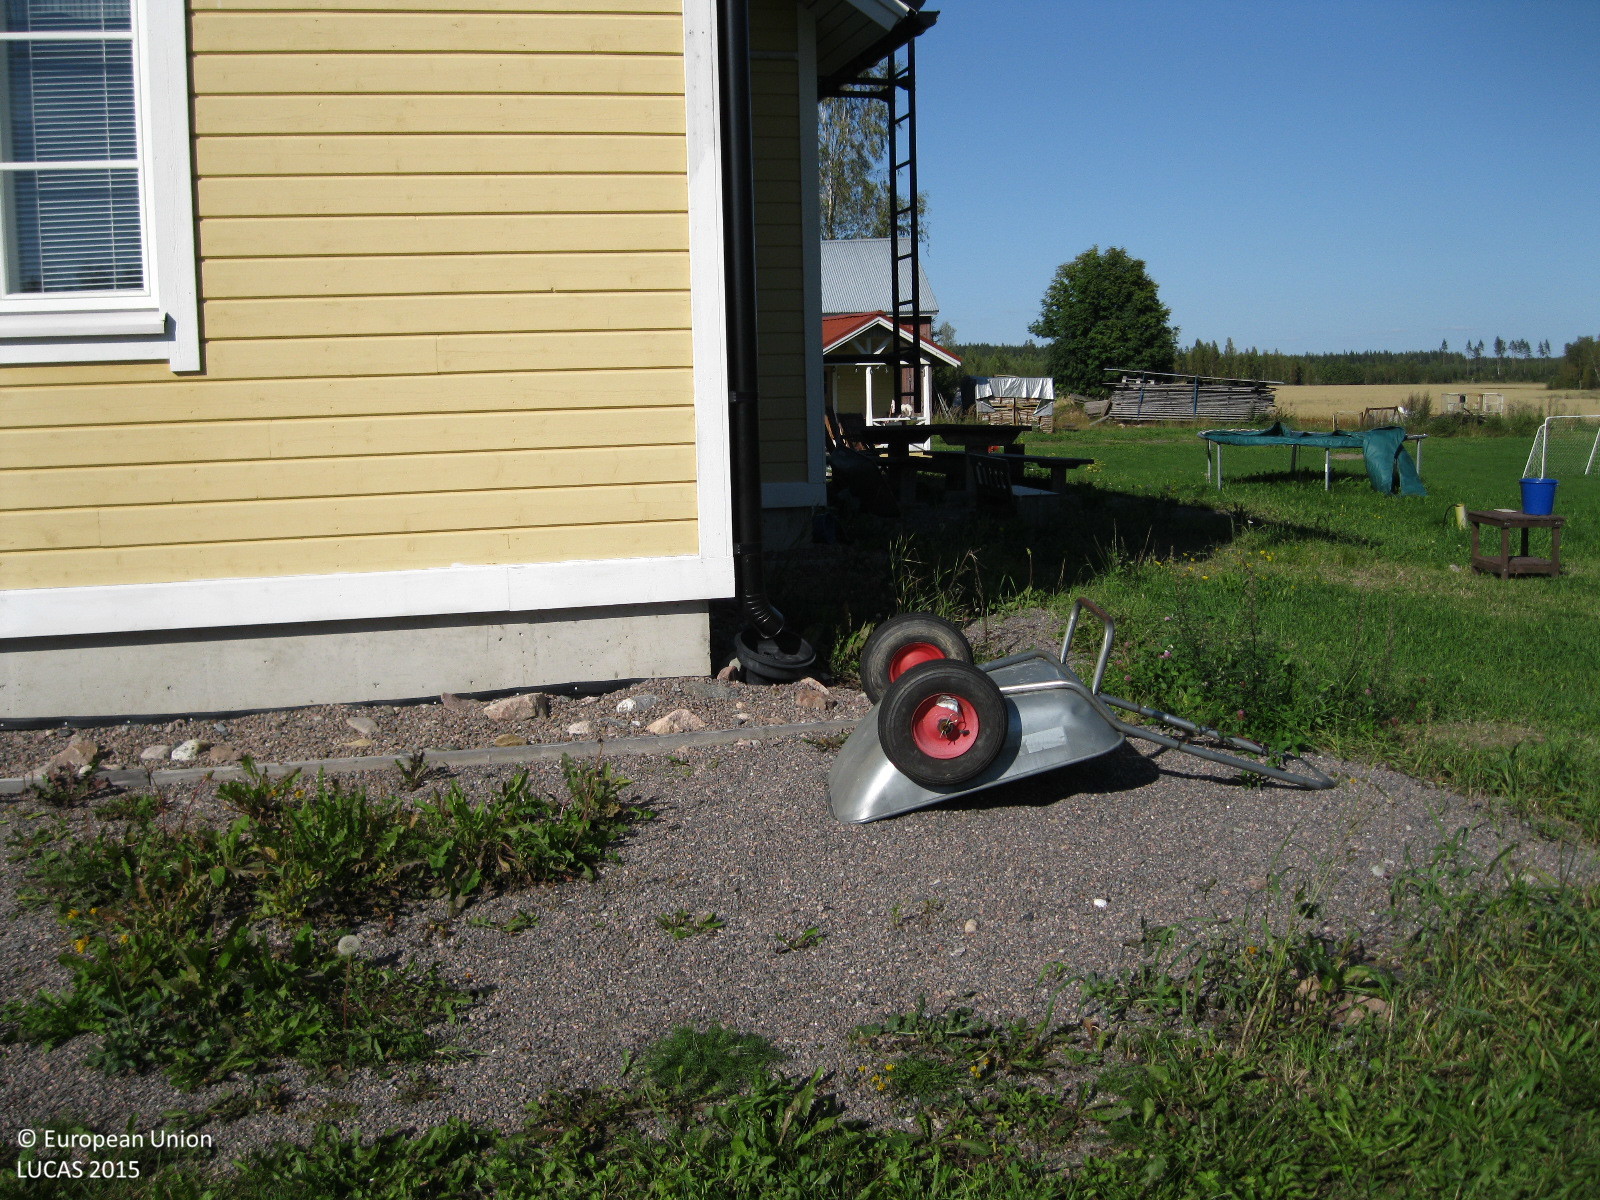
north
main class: Grassland
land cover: Grassland with sparse tree/shrub cover
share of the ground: > 75 %
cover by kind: herbaceous plants 95 %, coniferous forest trees 5 %
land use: Residential
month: September
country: FI
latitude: 60.6595
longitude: 24.9901
